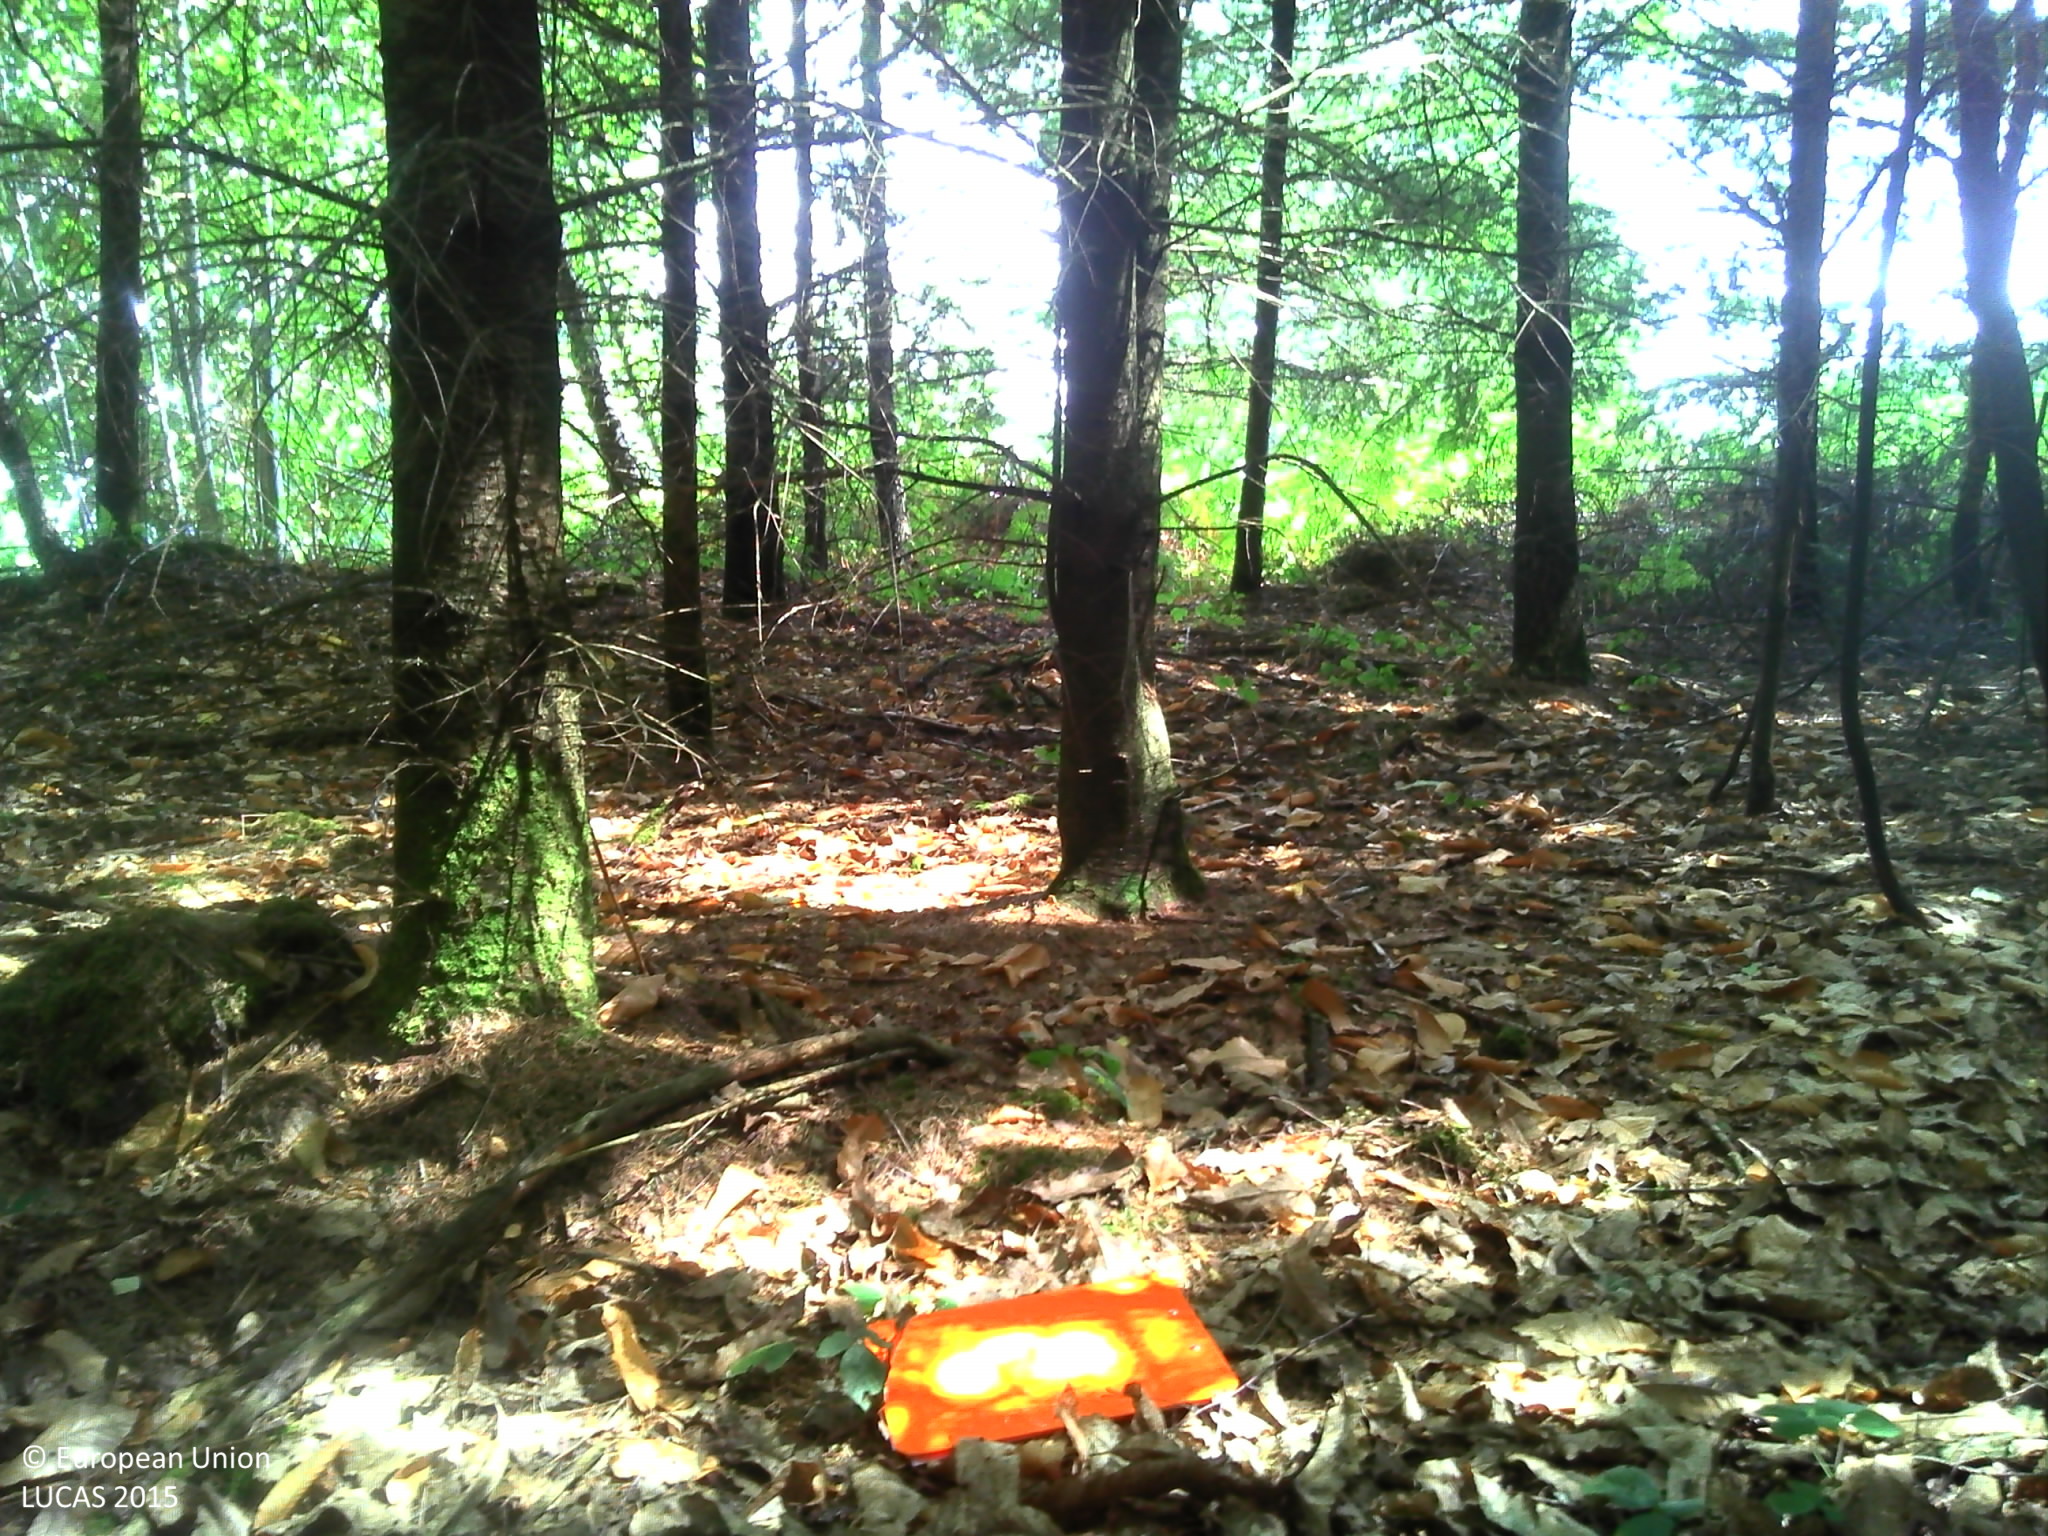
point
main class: Woodland
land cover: Spruce dominated coniferous woodland
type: exotic forest
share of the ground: > 75 %
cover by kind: coniferous forest trees 90 %, shrubs 5 %, herbaceous plants 5 %
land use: Forestry
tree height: > 5 m
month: July
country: FR
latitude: 46.0437
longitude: 4.4326
